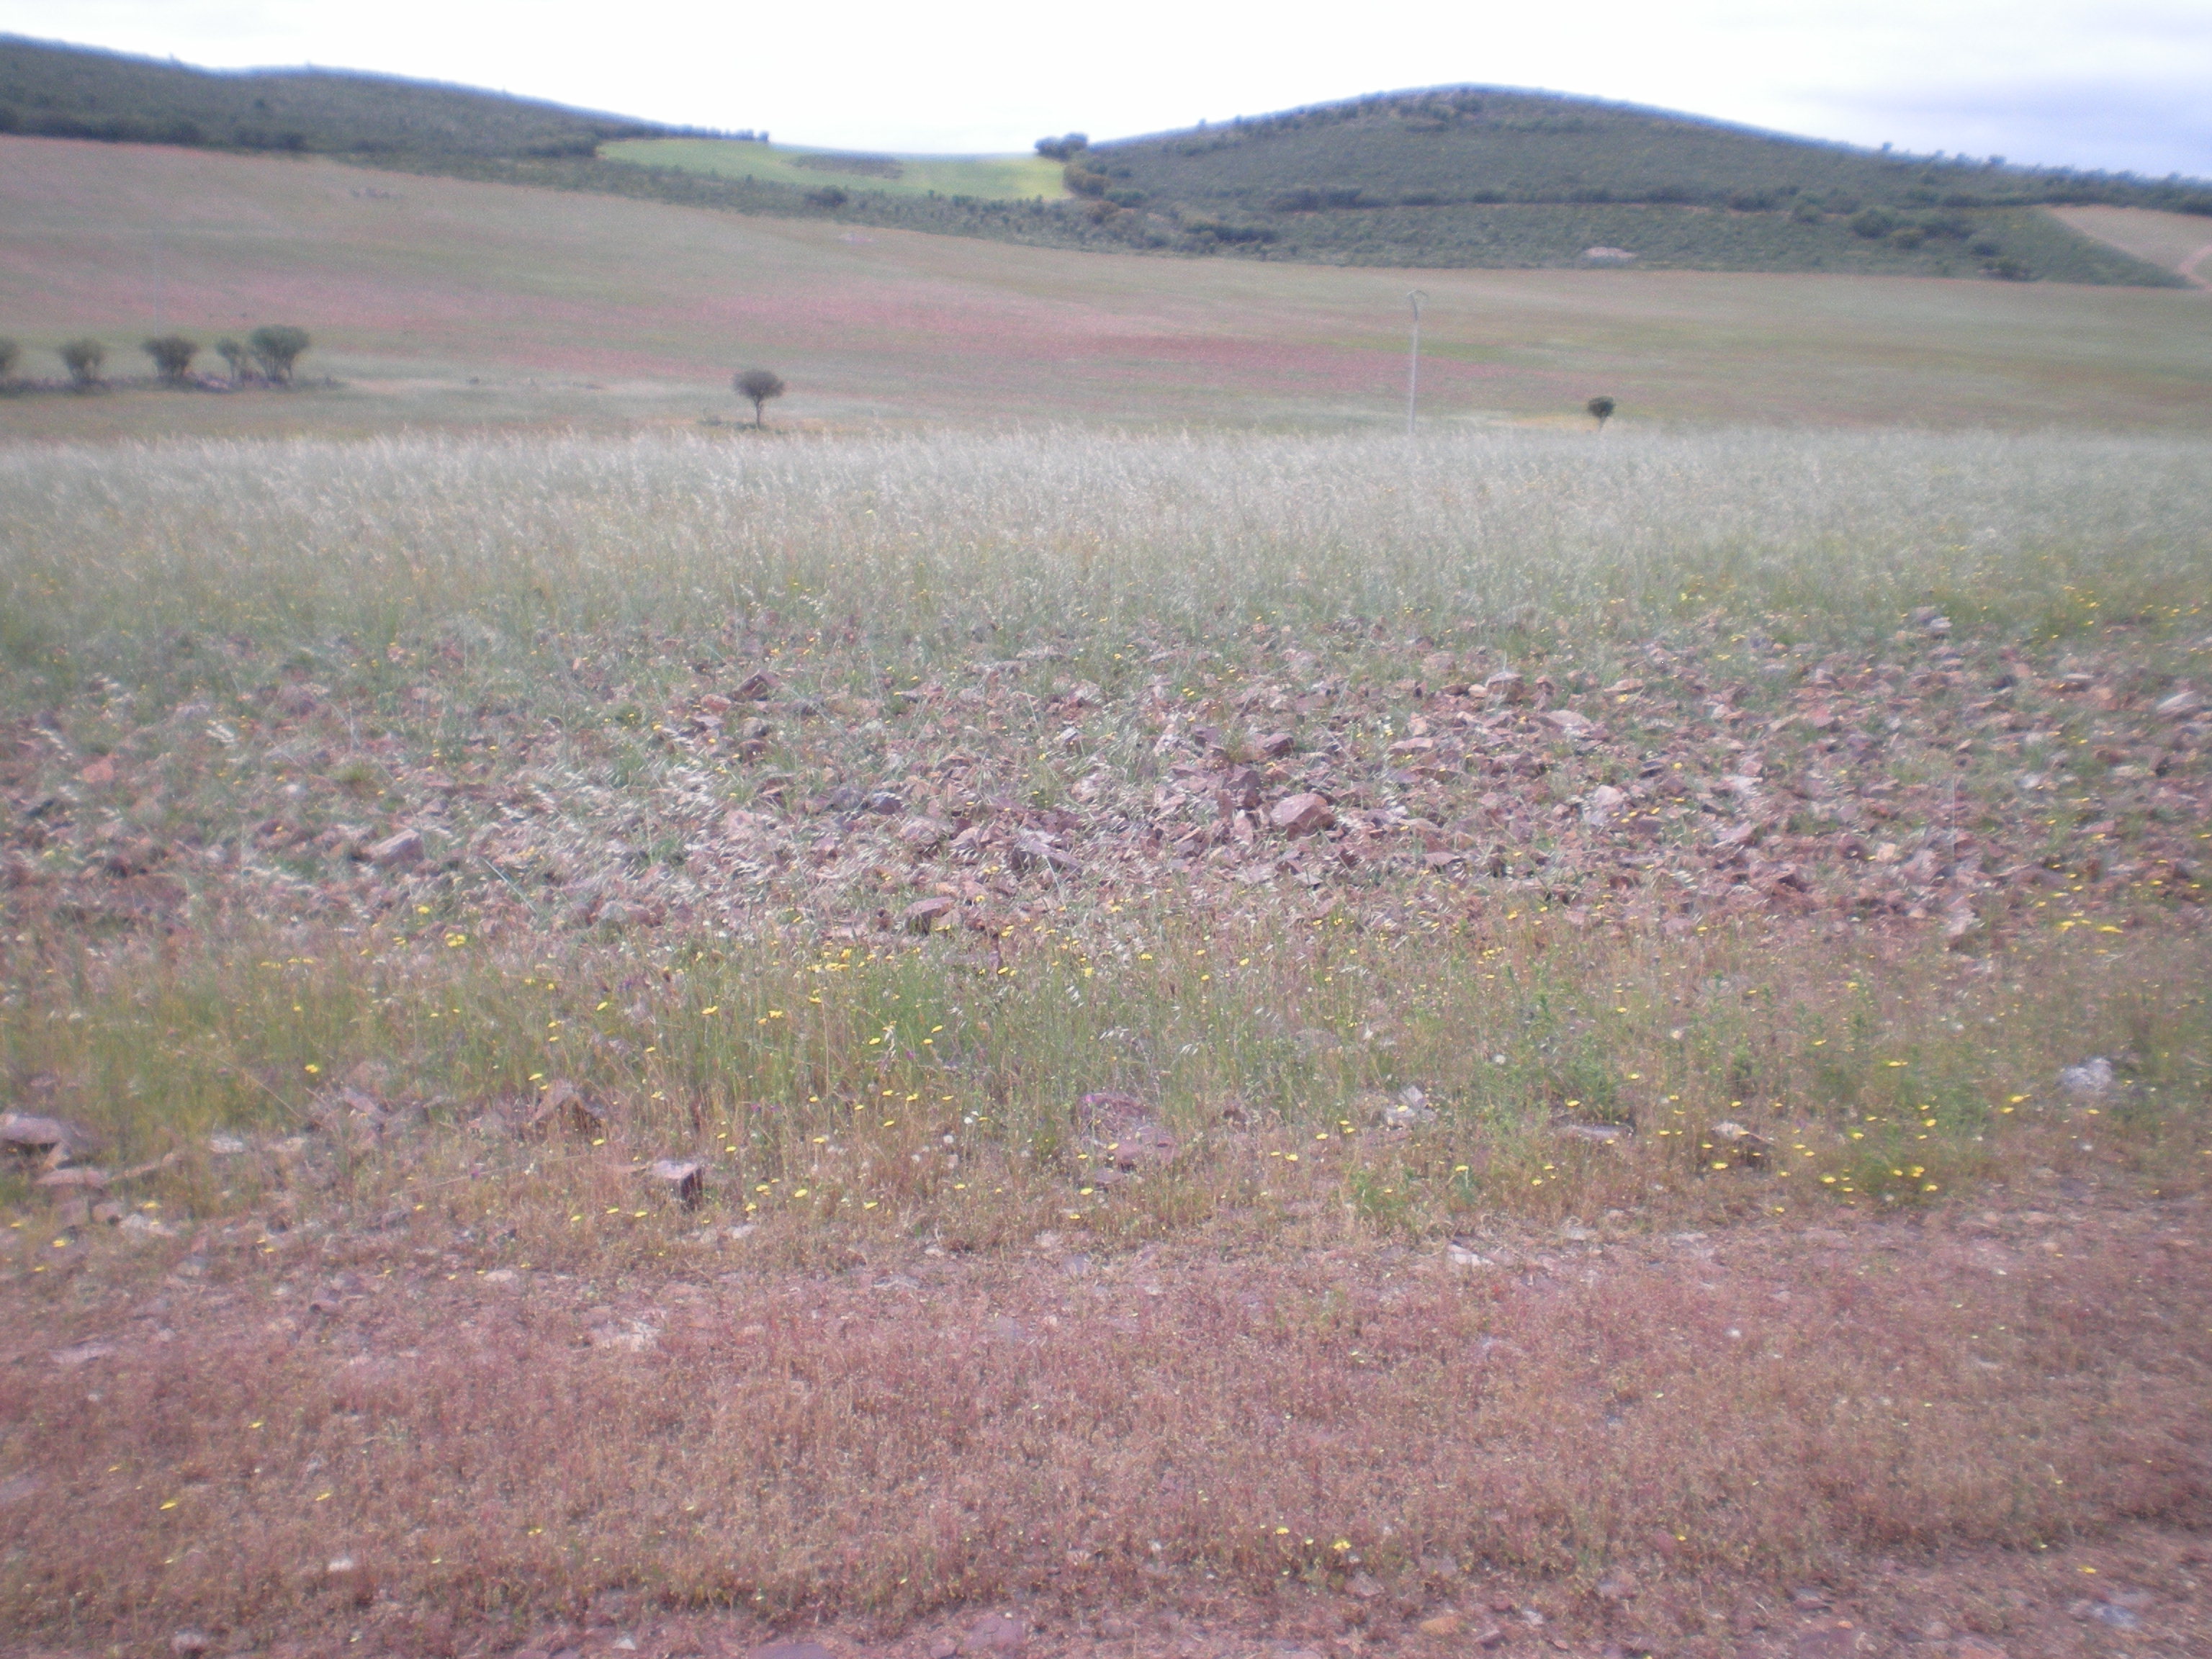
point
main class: Grassland
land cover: Spontaneously vegetated surfaces
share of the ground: 25 - 50 %
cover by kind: unconsolidated bare surface 75 %, herbaceous plants 25 %
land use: Fallow land
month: May
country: ES
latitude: 38.8344
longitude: -3.5031
